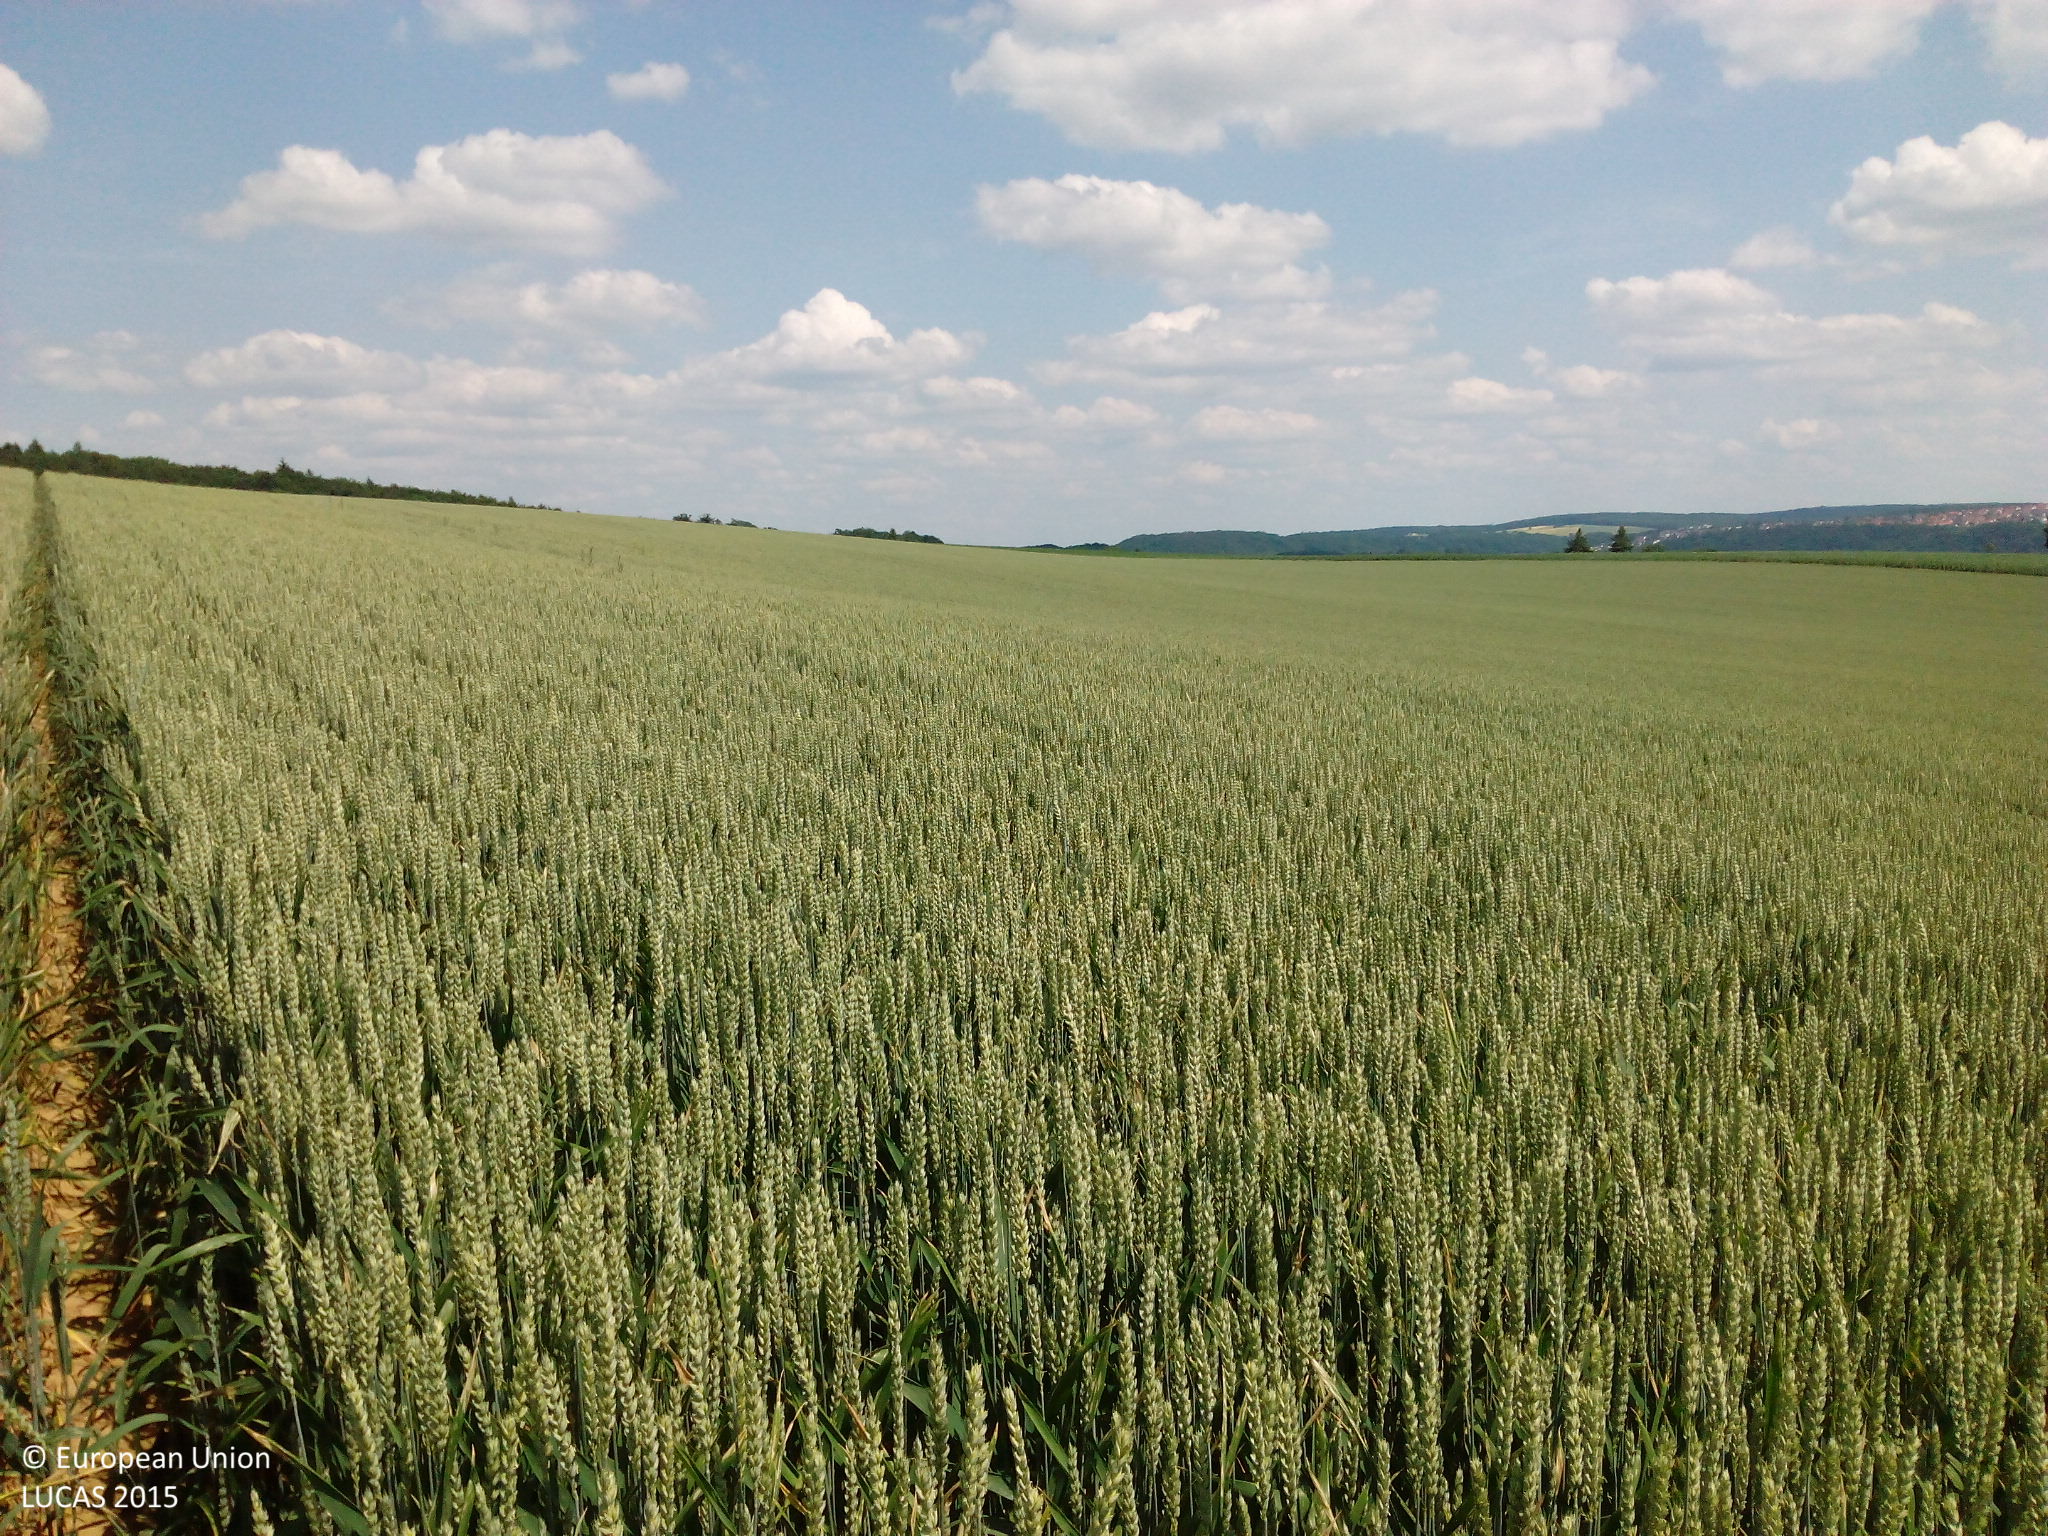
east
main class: Cropland
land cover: Common wheat
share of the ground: > 75 %
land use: Agriculture (excluding fallow land and kitchen gardens)
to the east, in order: Common wheat
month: June
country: DE
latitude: 49.3022
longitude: 9.5738
